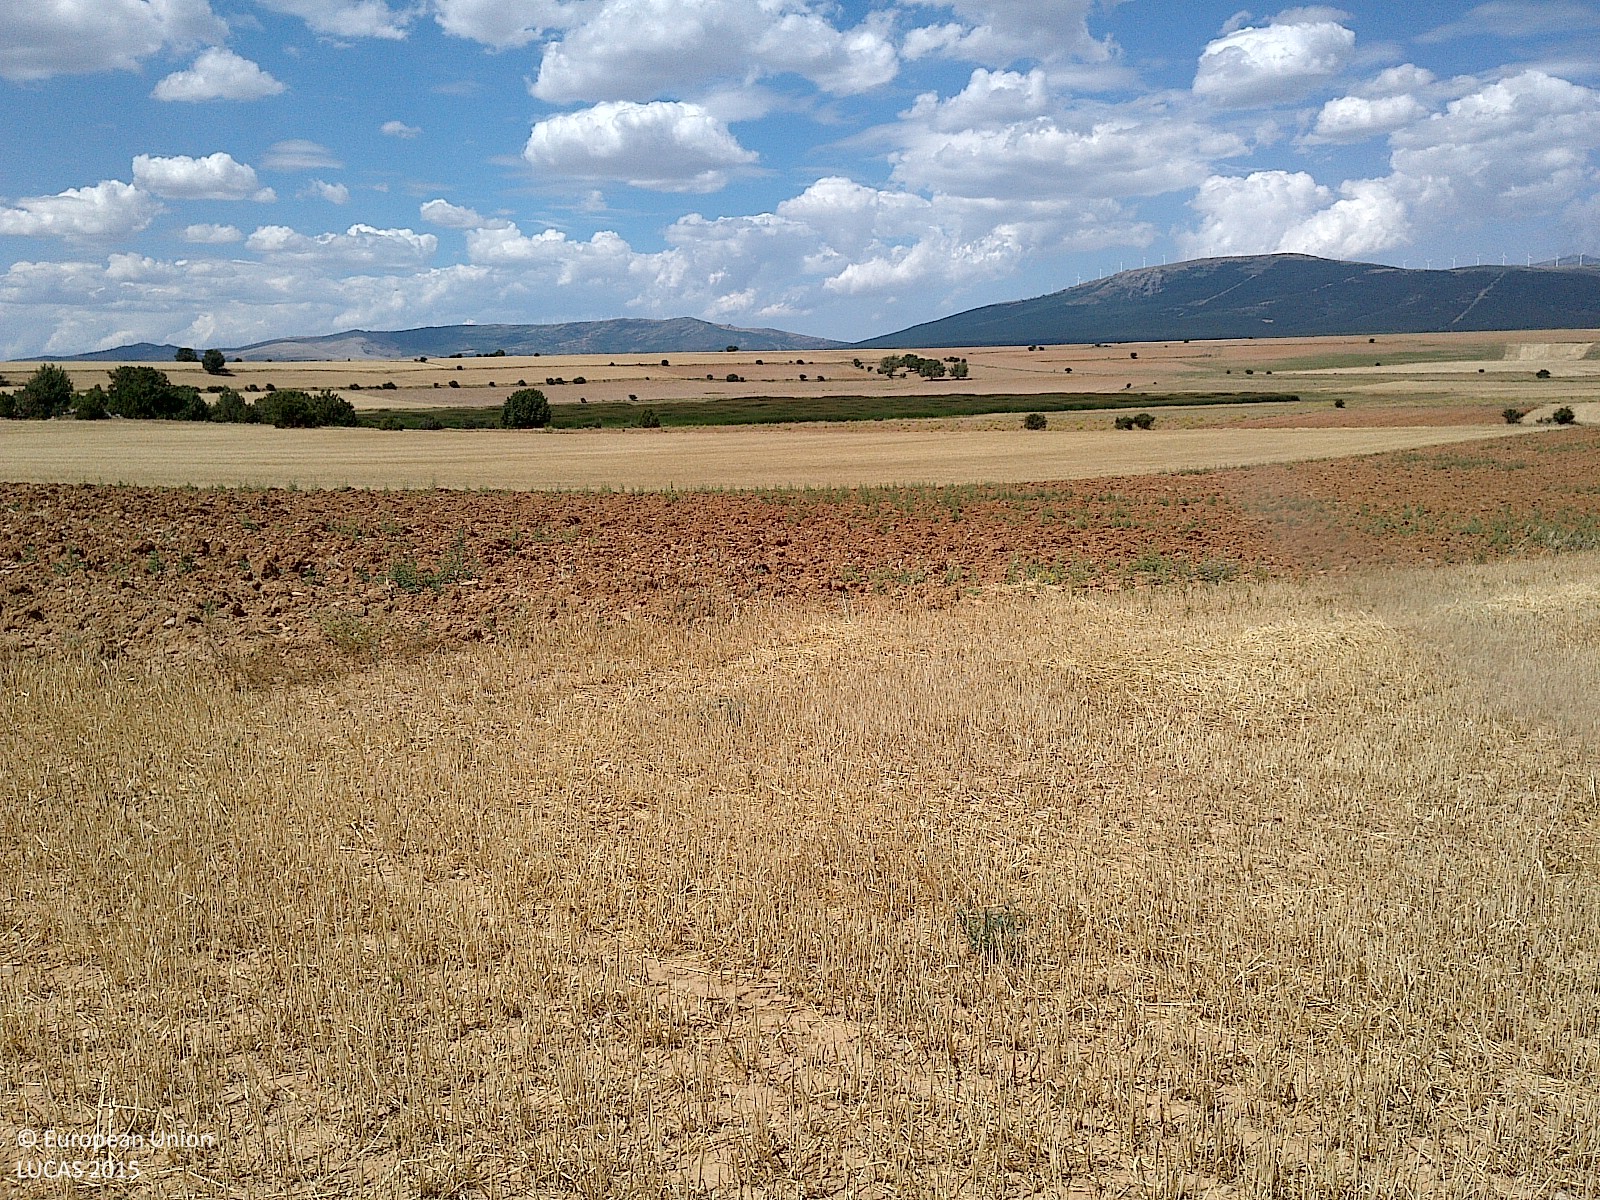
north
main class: Cropland
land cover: Barley
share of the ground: < 10 %
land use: Agriculture (excluding fallow land and kitchen gardens)
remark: Harvested field
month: July
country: ES
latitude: 41.6514
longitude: -1.9547
